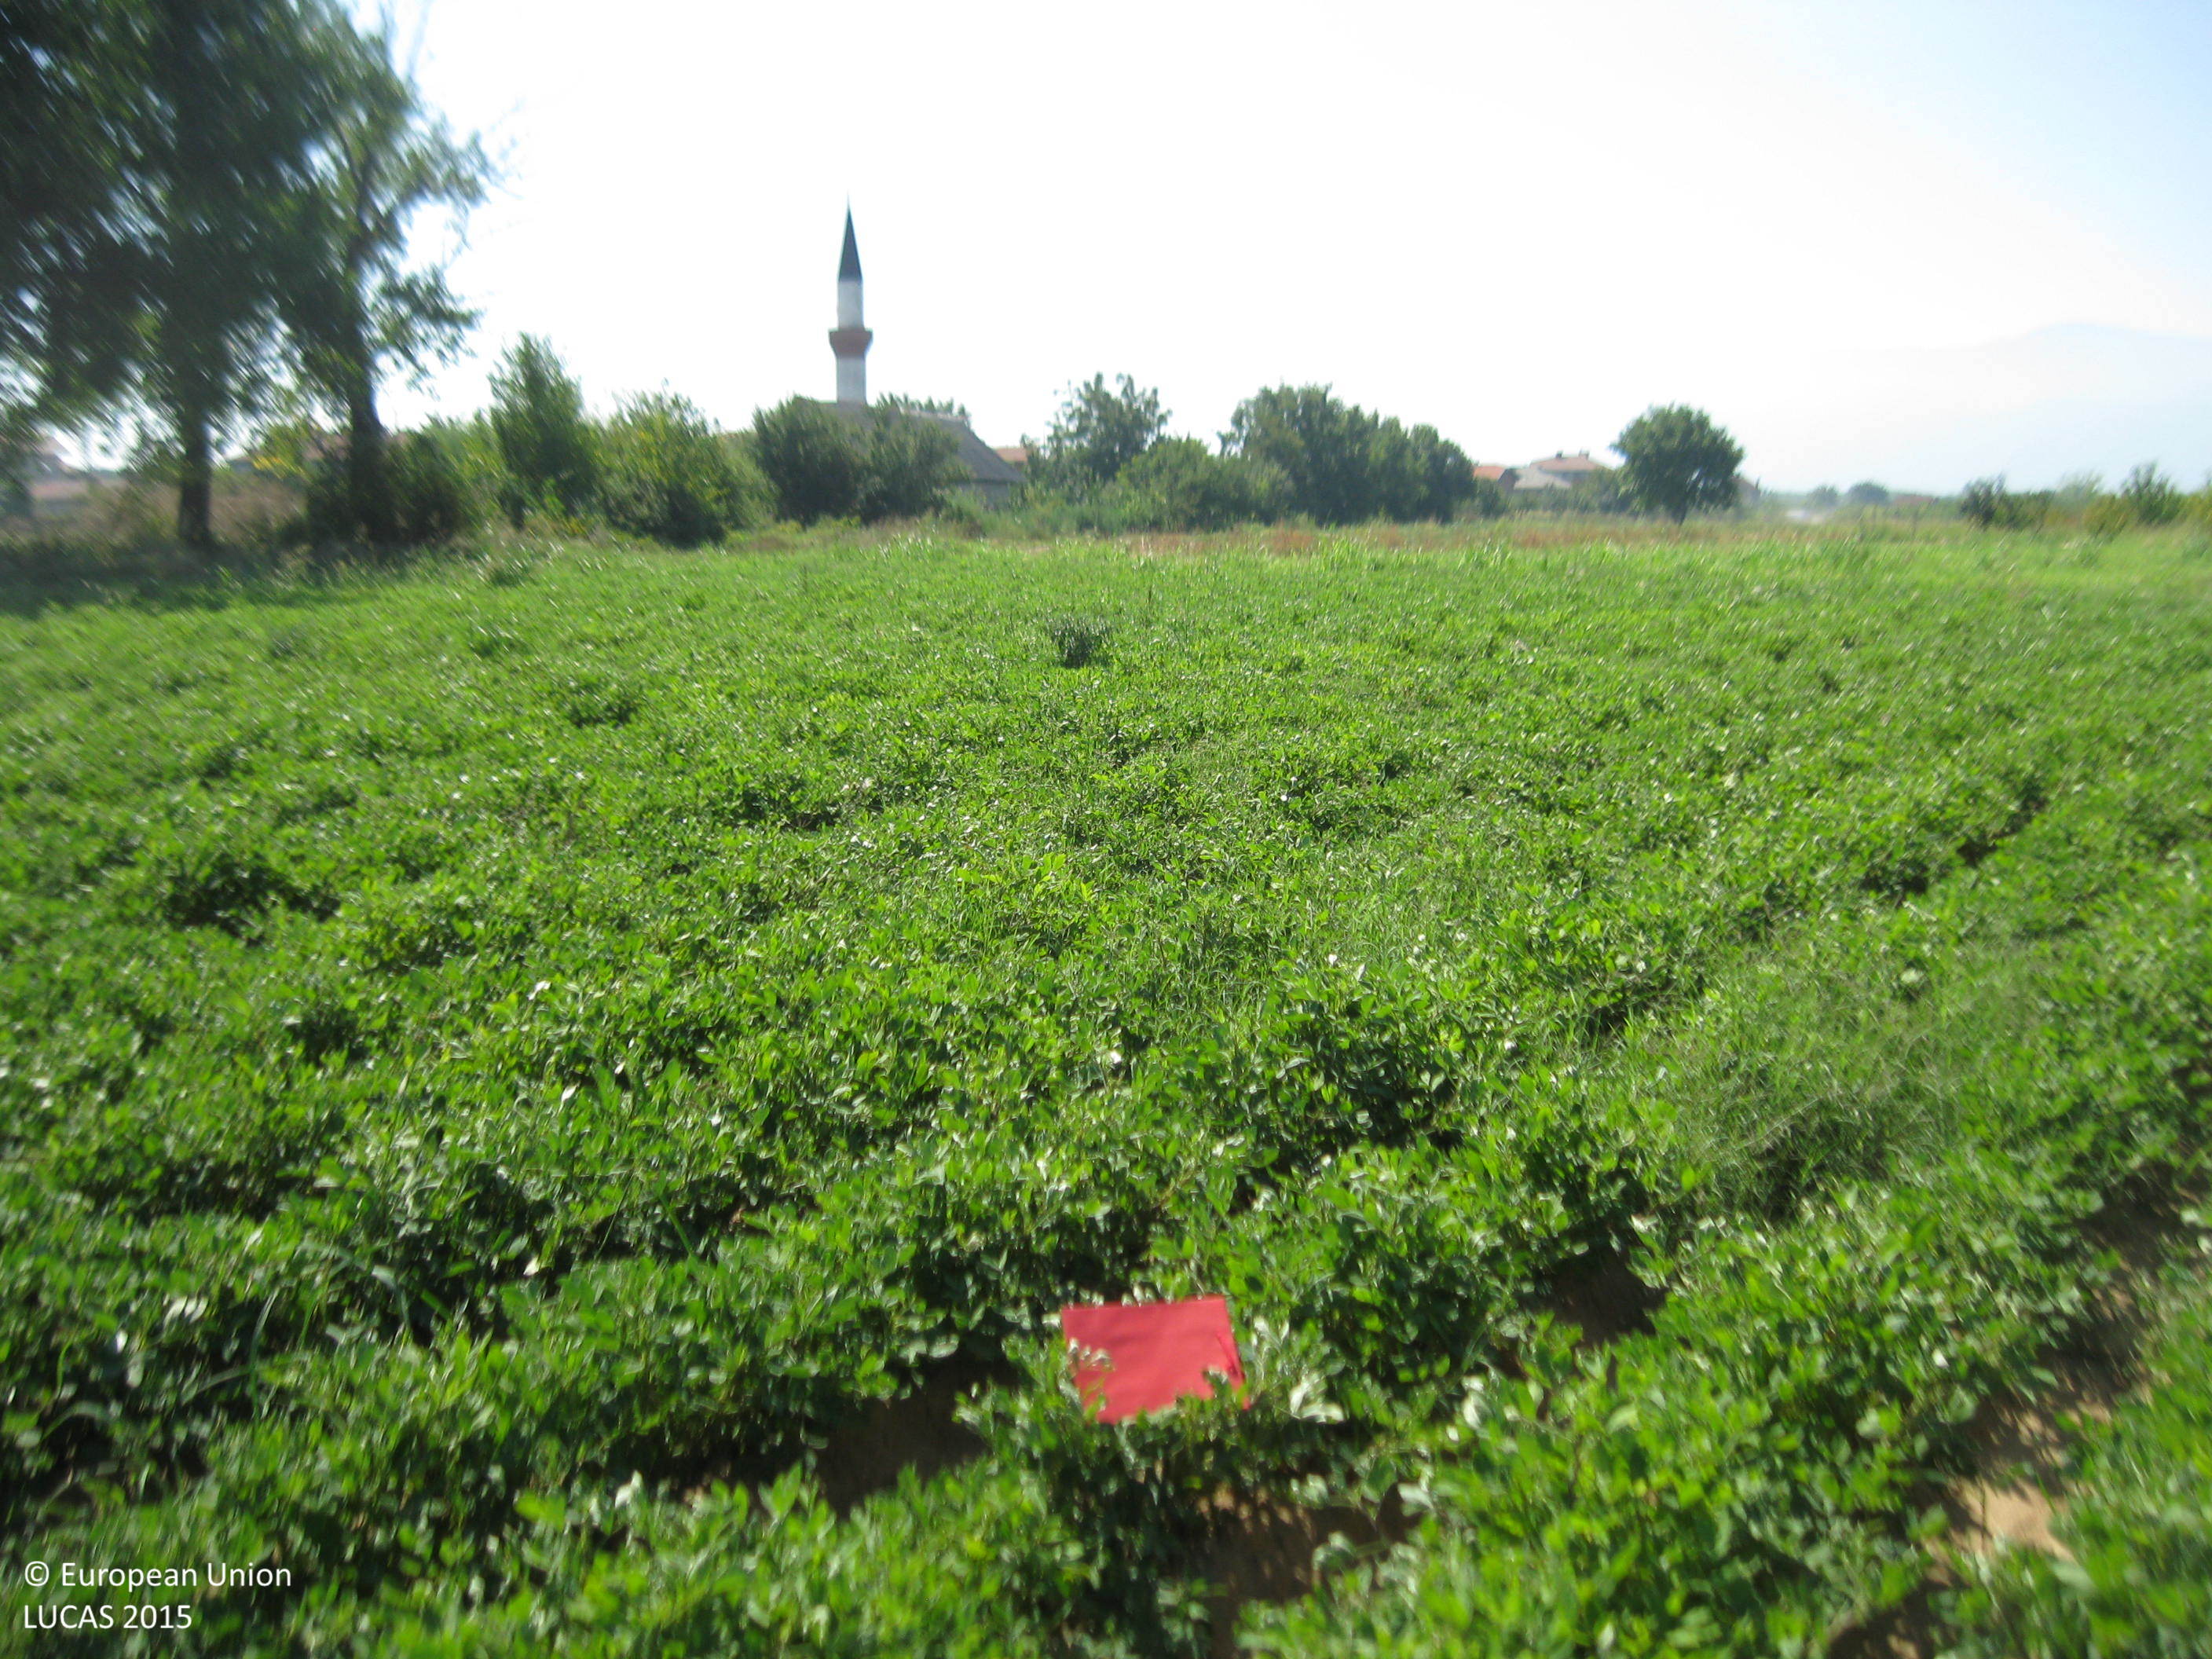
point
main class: Cropland
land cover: Soya
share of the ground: > 75 %
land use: Agriculture (excluding fallow land and kitchen gardens)
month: September
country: BG
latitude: 42.0752
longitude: 24.9085
